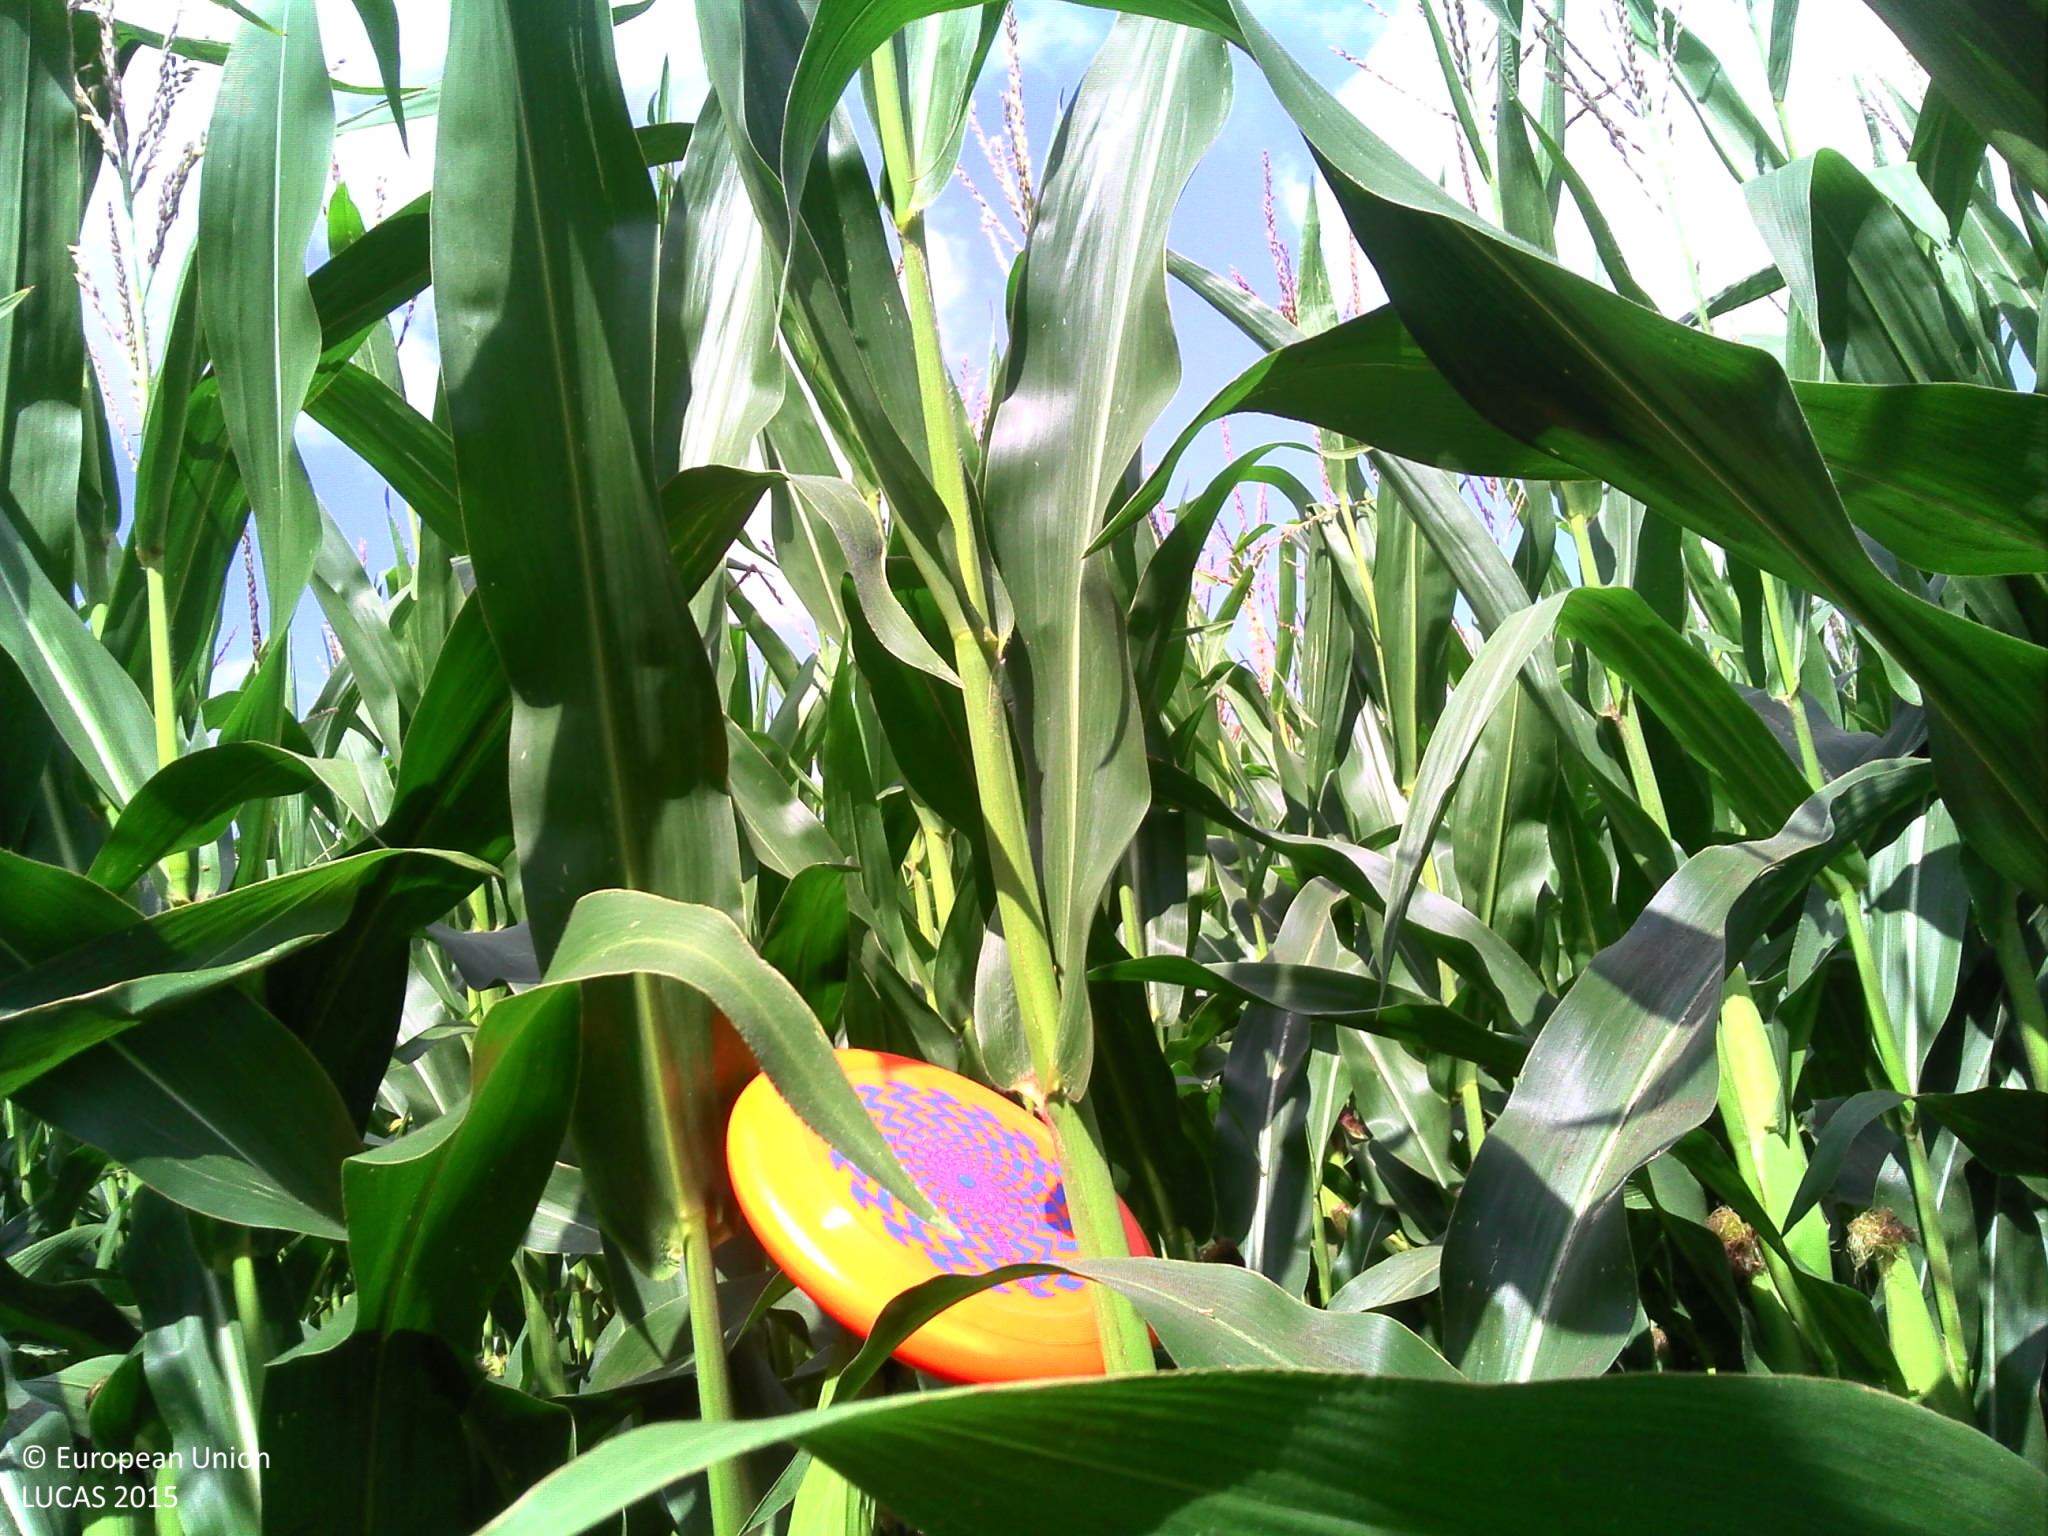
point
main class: Cropland
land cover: Maize
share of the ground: > 75 %
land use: Agriculture (excluding fallow land and kitchen gardens)
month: August
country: FR
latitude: 48.3097
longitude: -2.1775
